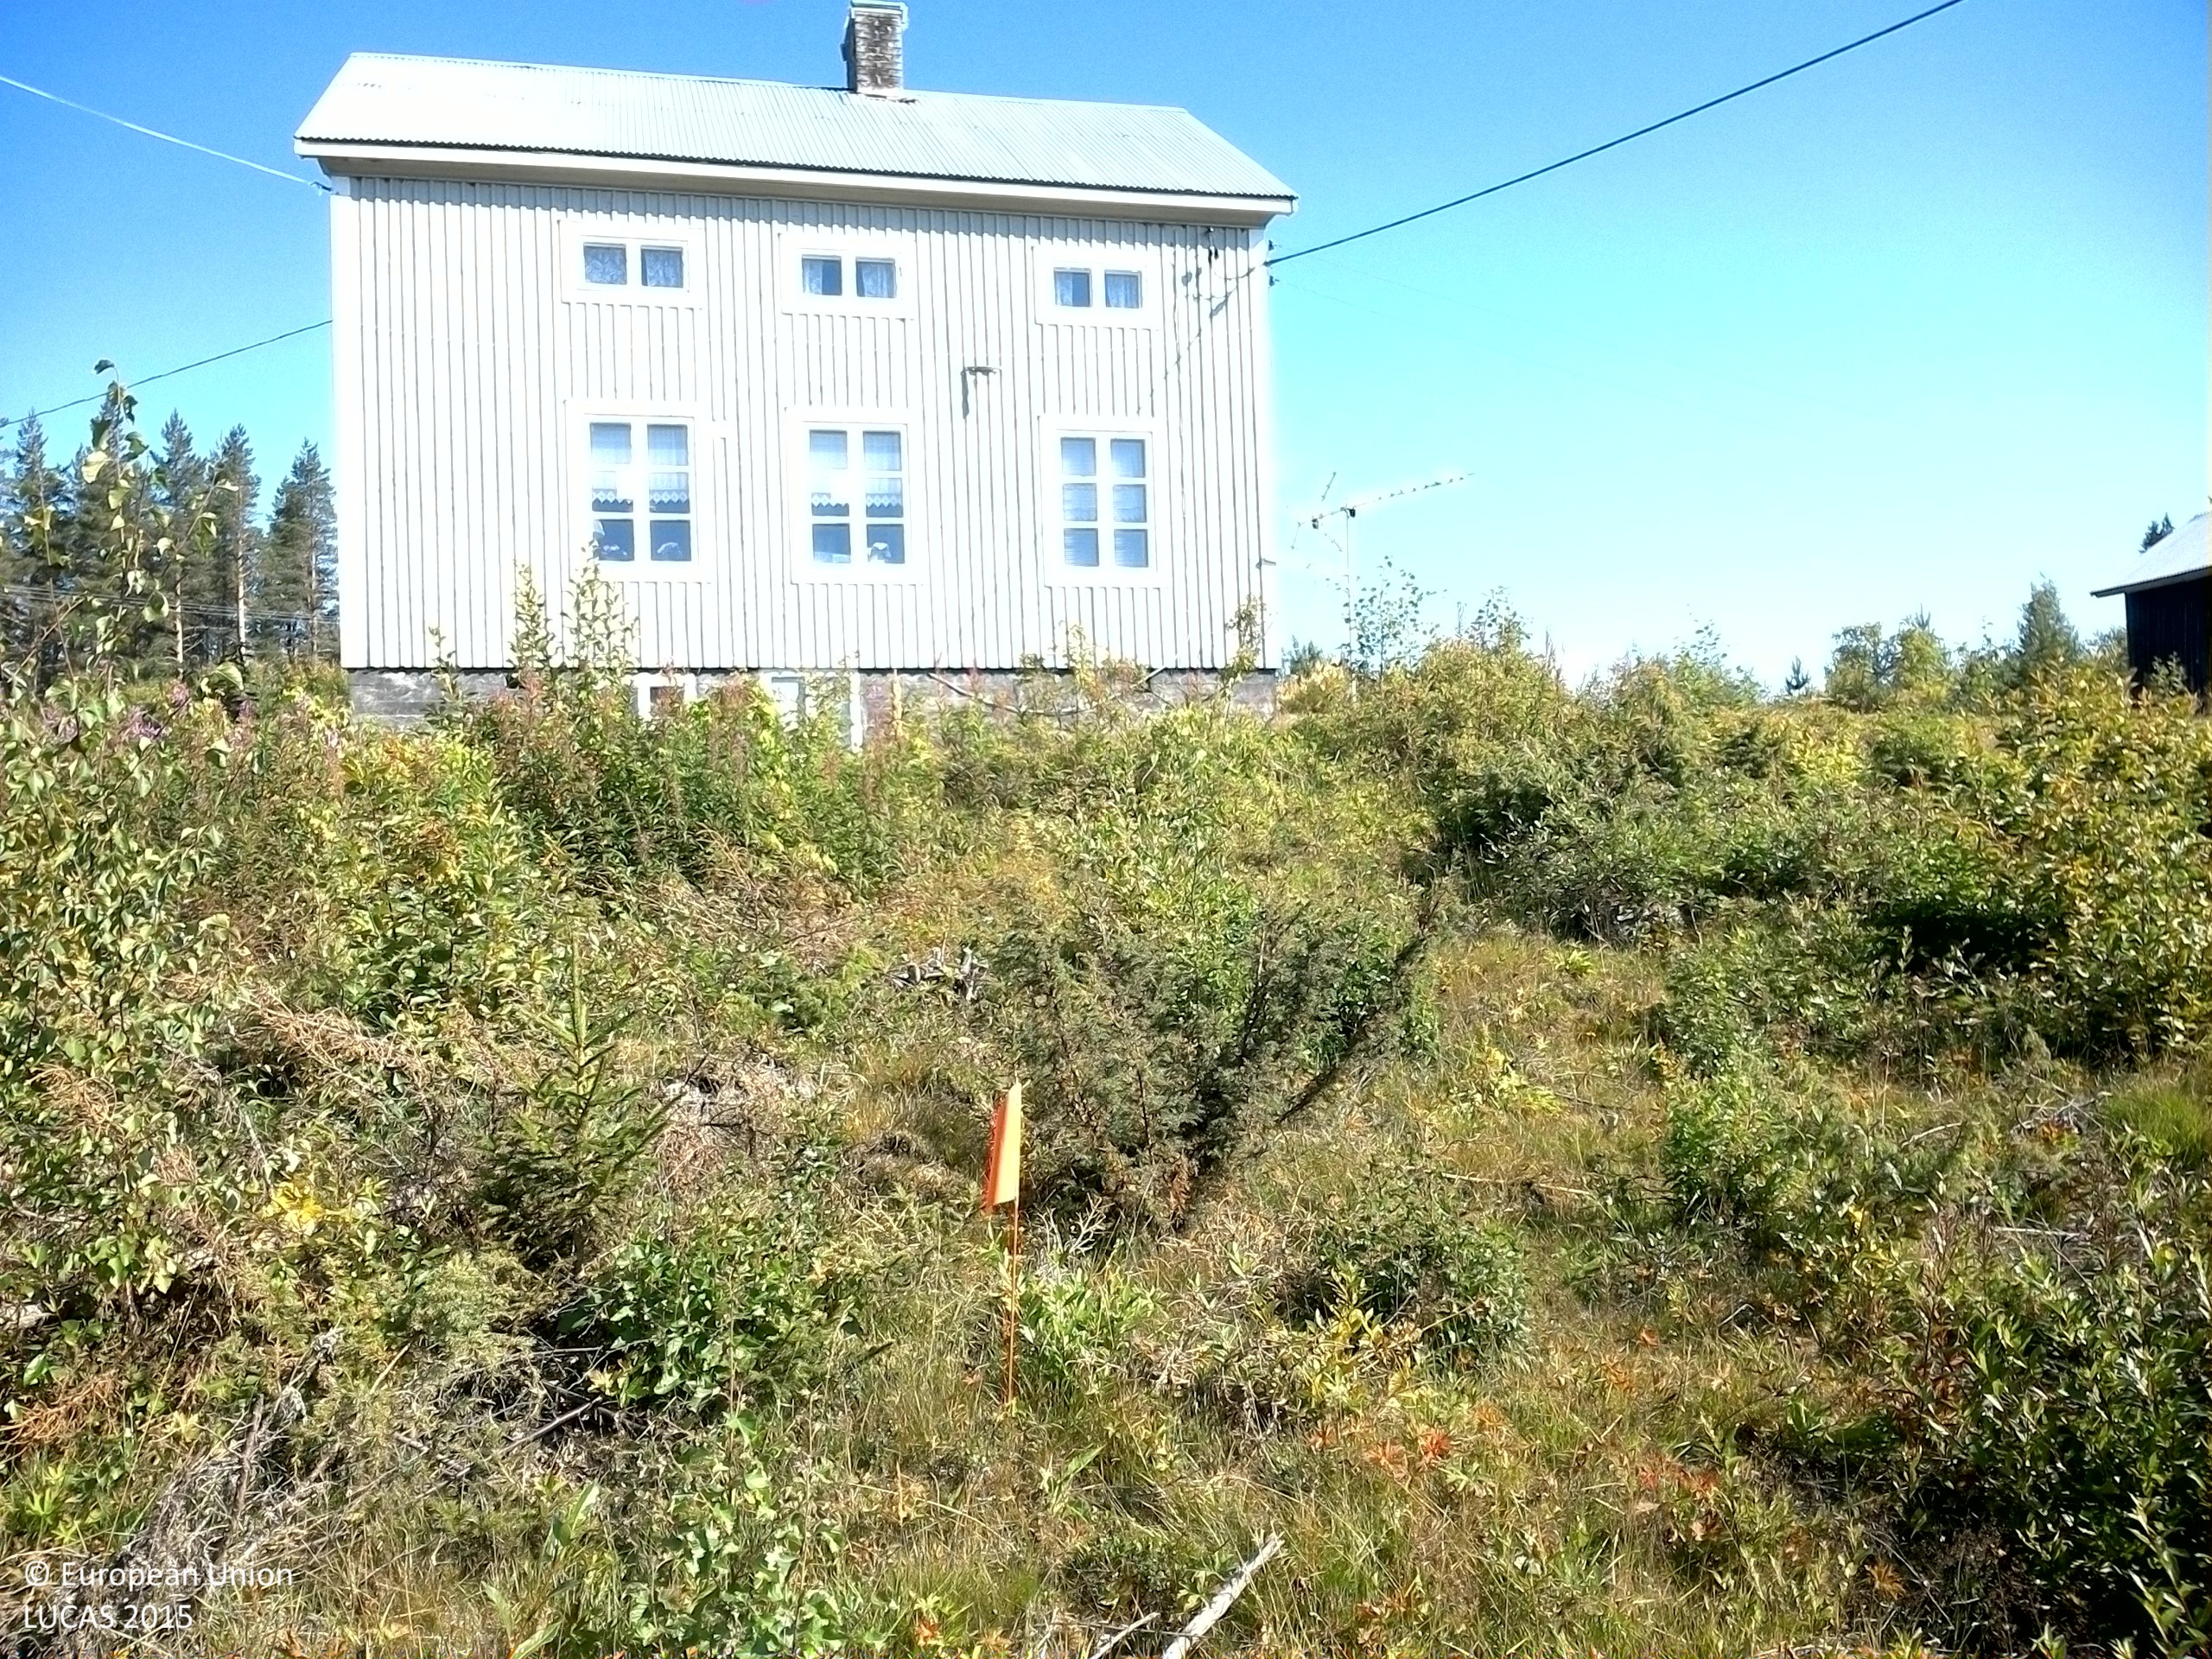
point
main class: Woodland
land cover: Spruce dominated mixed woodland
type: boreal forest
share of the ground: 25 - 50 %
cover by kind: herbaceous plants 50 %, coniferous forest trees 15 %, broadleaved forest trees 15 %, shrubs 15 %, lichens and mosses 5 %
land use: Residential
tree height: < 5 m
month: August
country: SE
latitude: 63.7693
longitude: 17.4551
